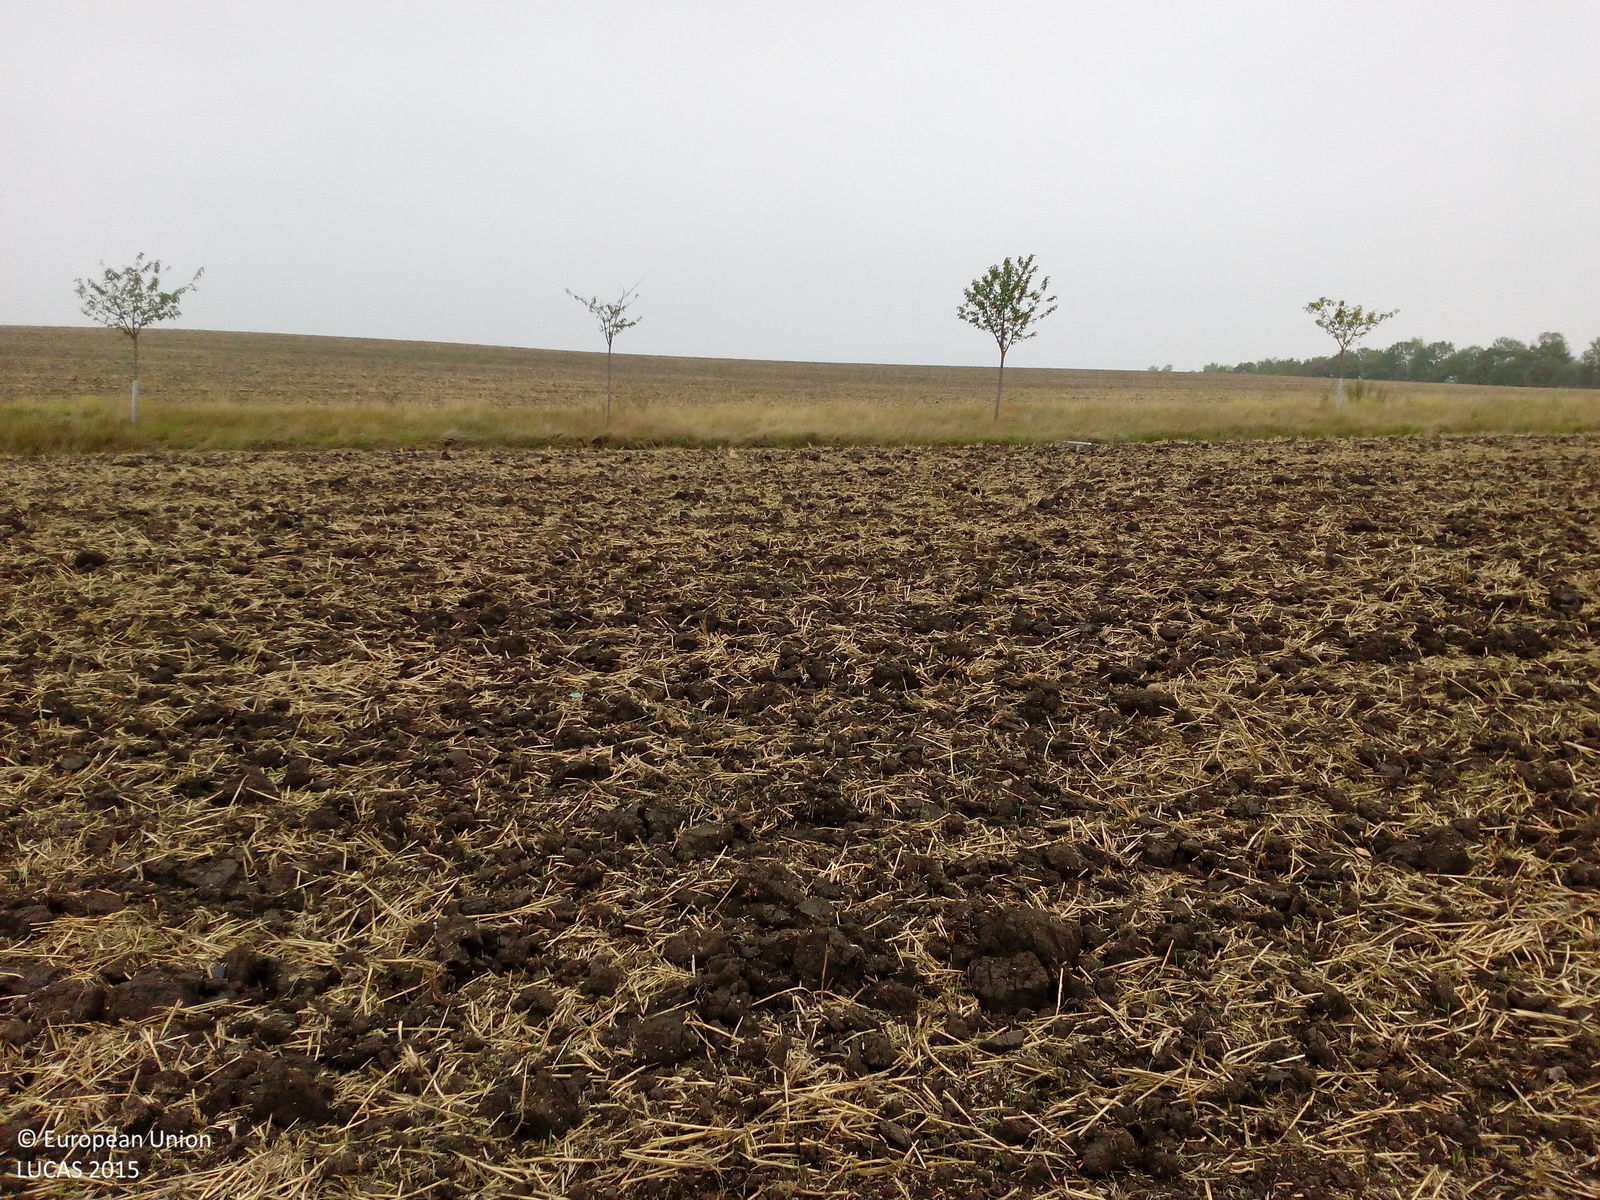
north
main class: Cropland
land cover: Common wheat
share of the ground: < 10 %
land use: Agriculture (excluding fallow land and kitchen gardens)
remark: Harvested field
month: August
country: DE
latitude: 51.0421
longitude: 11.0979
